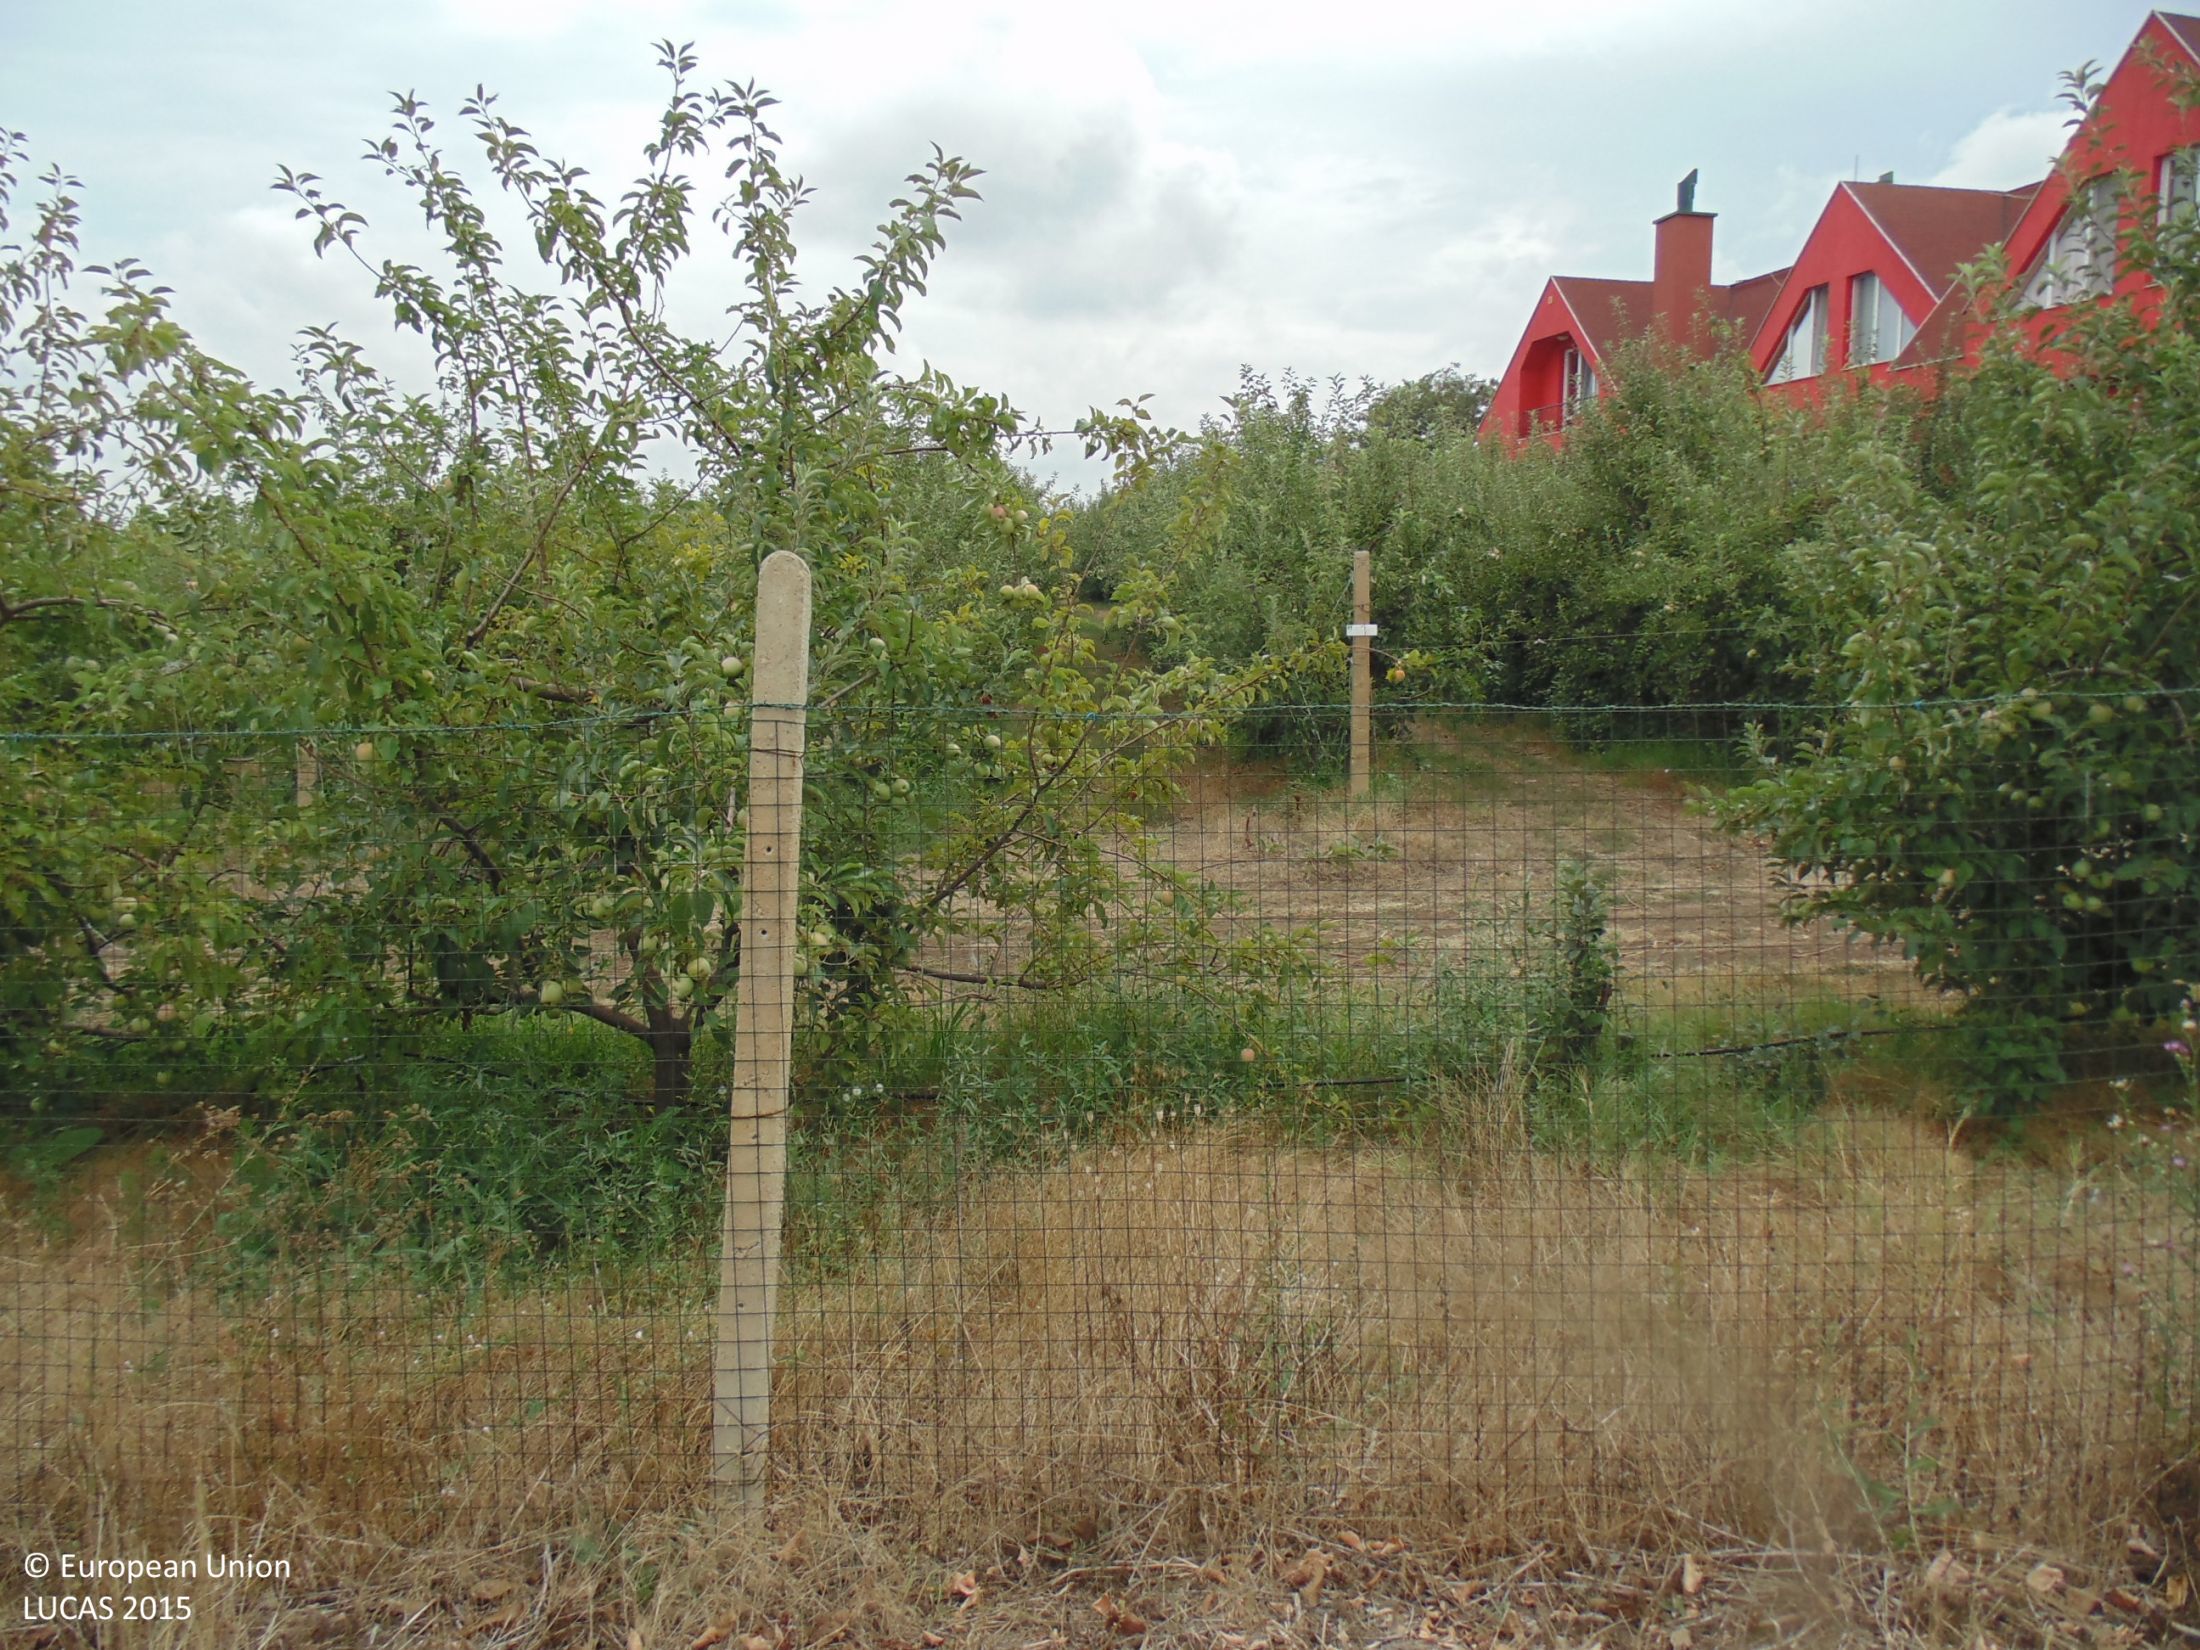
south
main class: Cropland
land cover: Apple fruit
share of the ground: > 75 %
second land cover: Spontaneously vegetated surfaces
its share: > 75 %
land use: Agriculture (excluding fallow land and kitchen gardens)
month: August
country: BG
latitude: 43.5914
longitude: 28.5064
